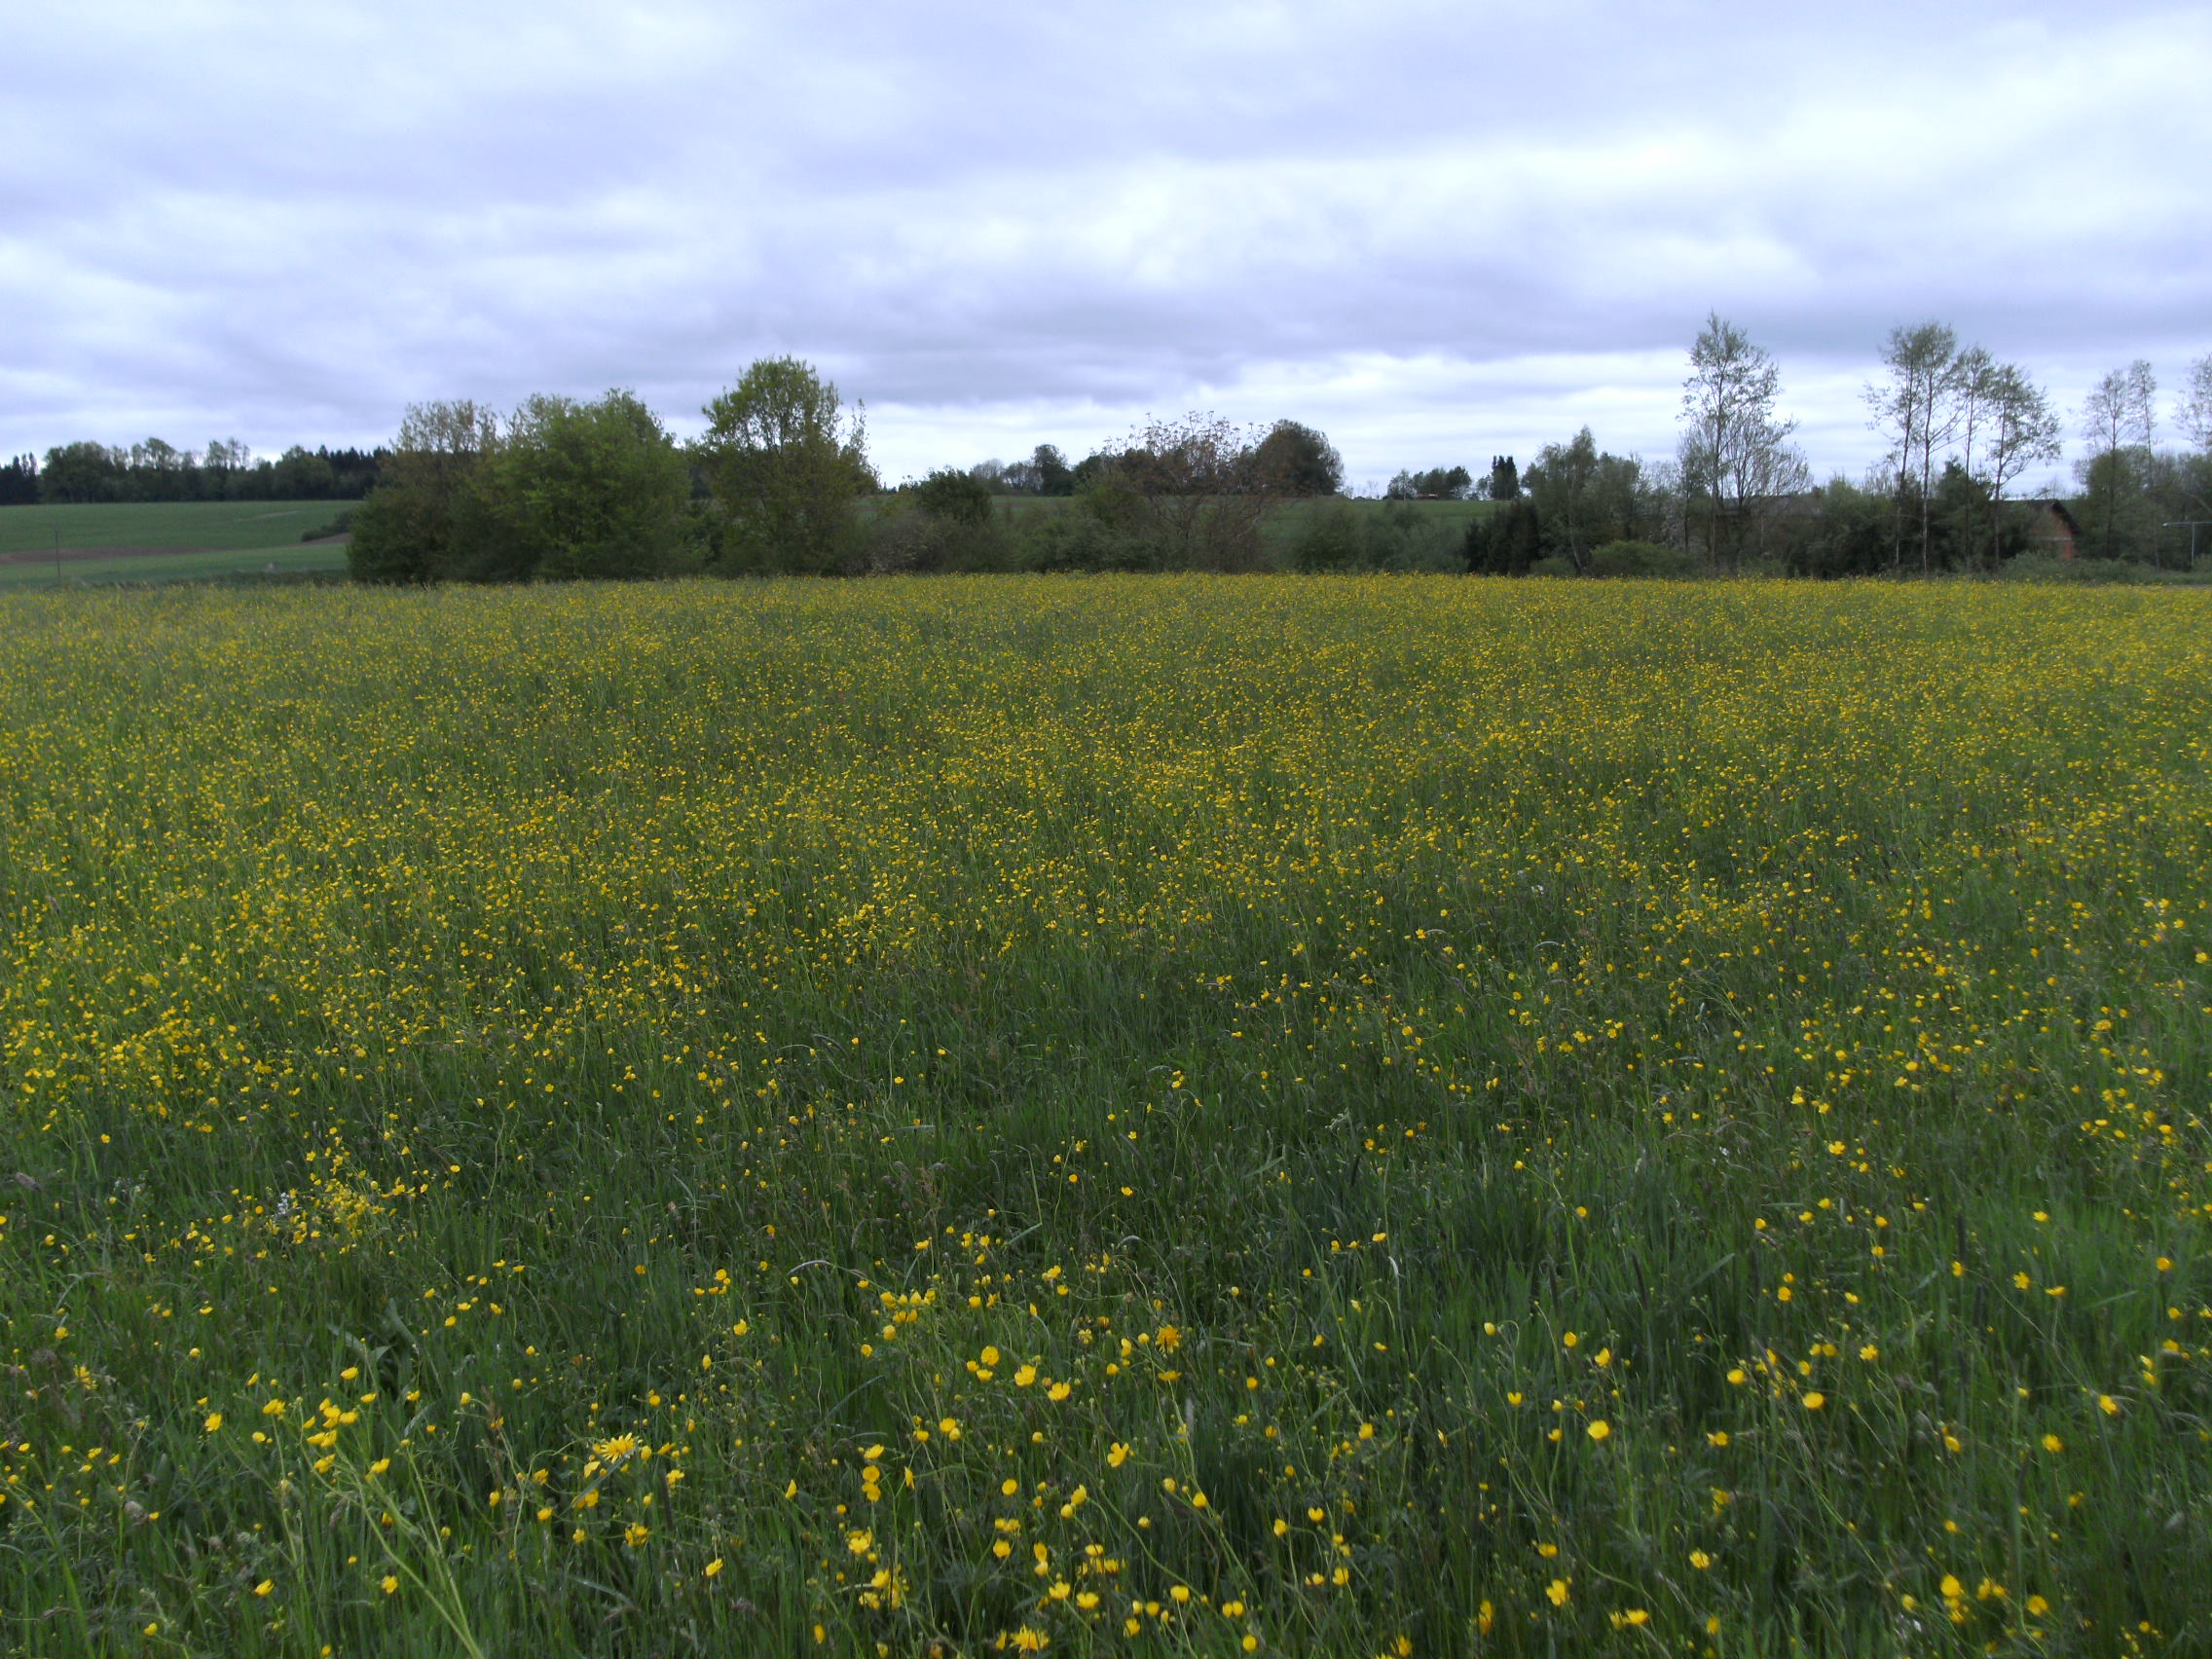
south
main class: Grassland
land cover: Grassland without tree/shrub cover
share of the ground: > 75 %
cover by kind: herbaceous plants 100 %
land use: Agriculture (excluding fallow land and kitchen gardens)
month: May
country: AT
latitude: 48.1899
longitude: 13.3756
